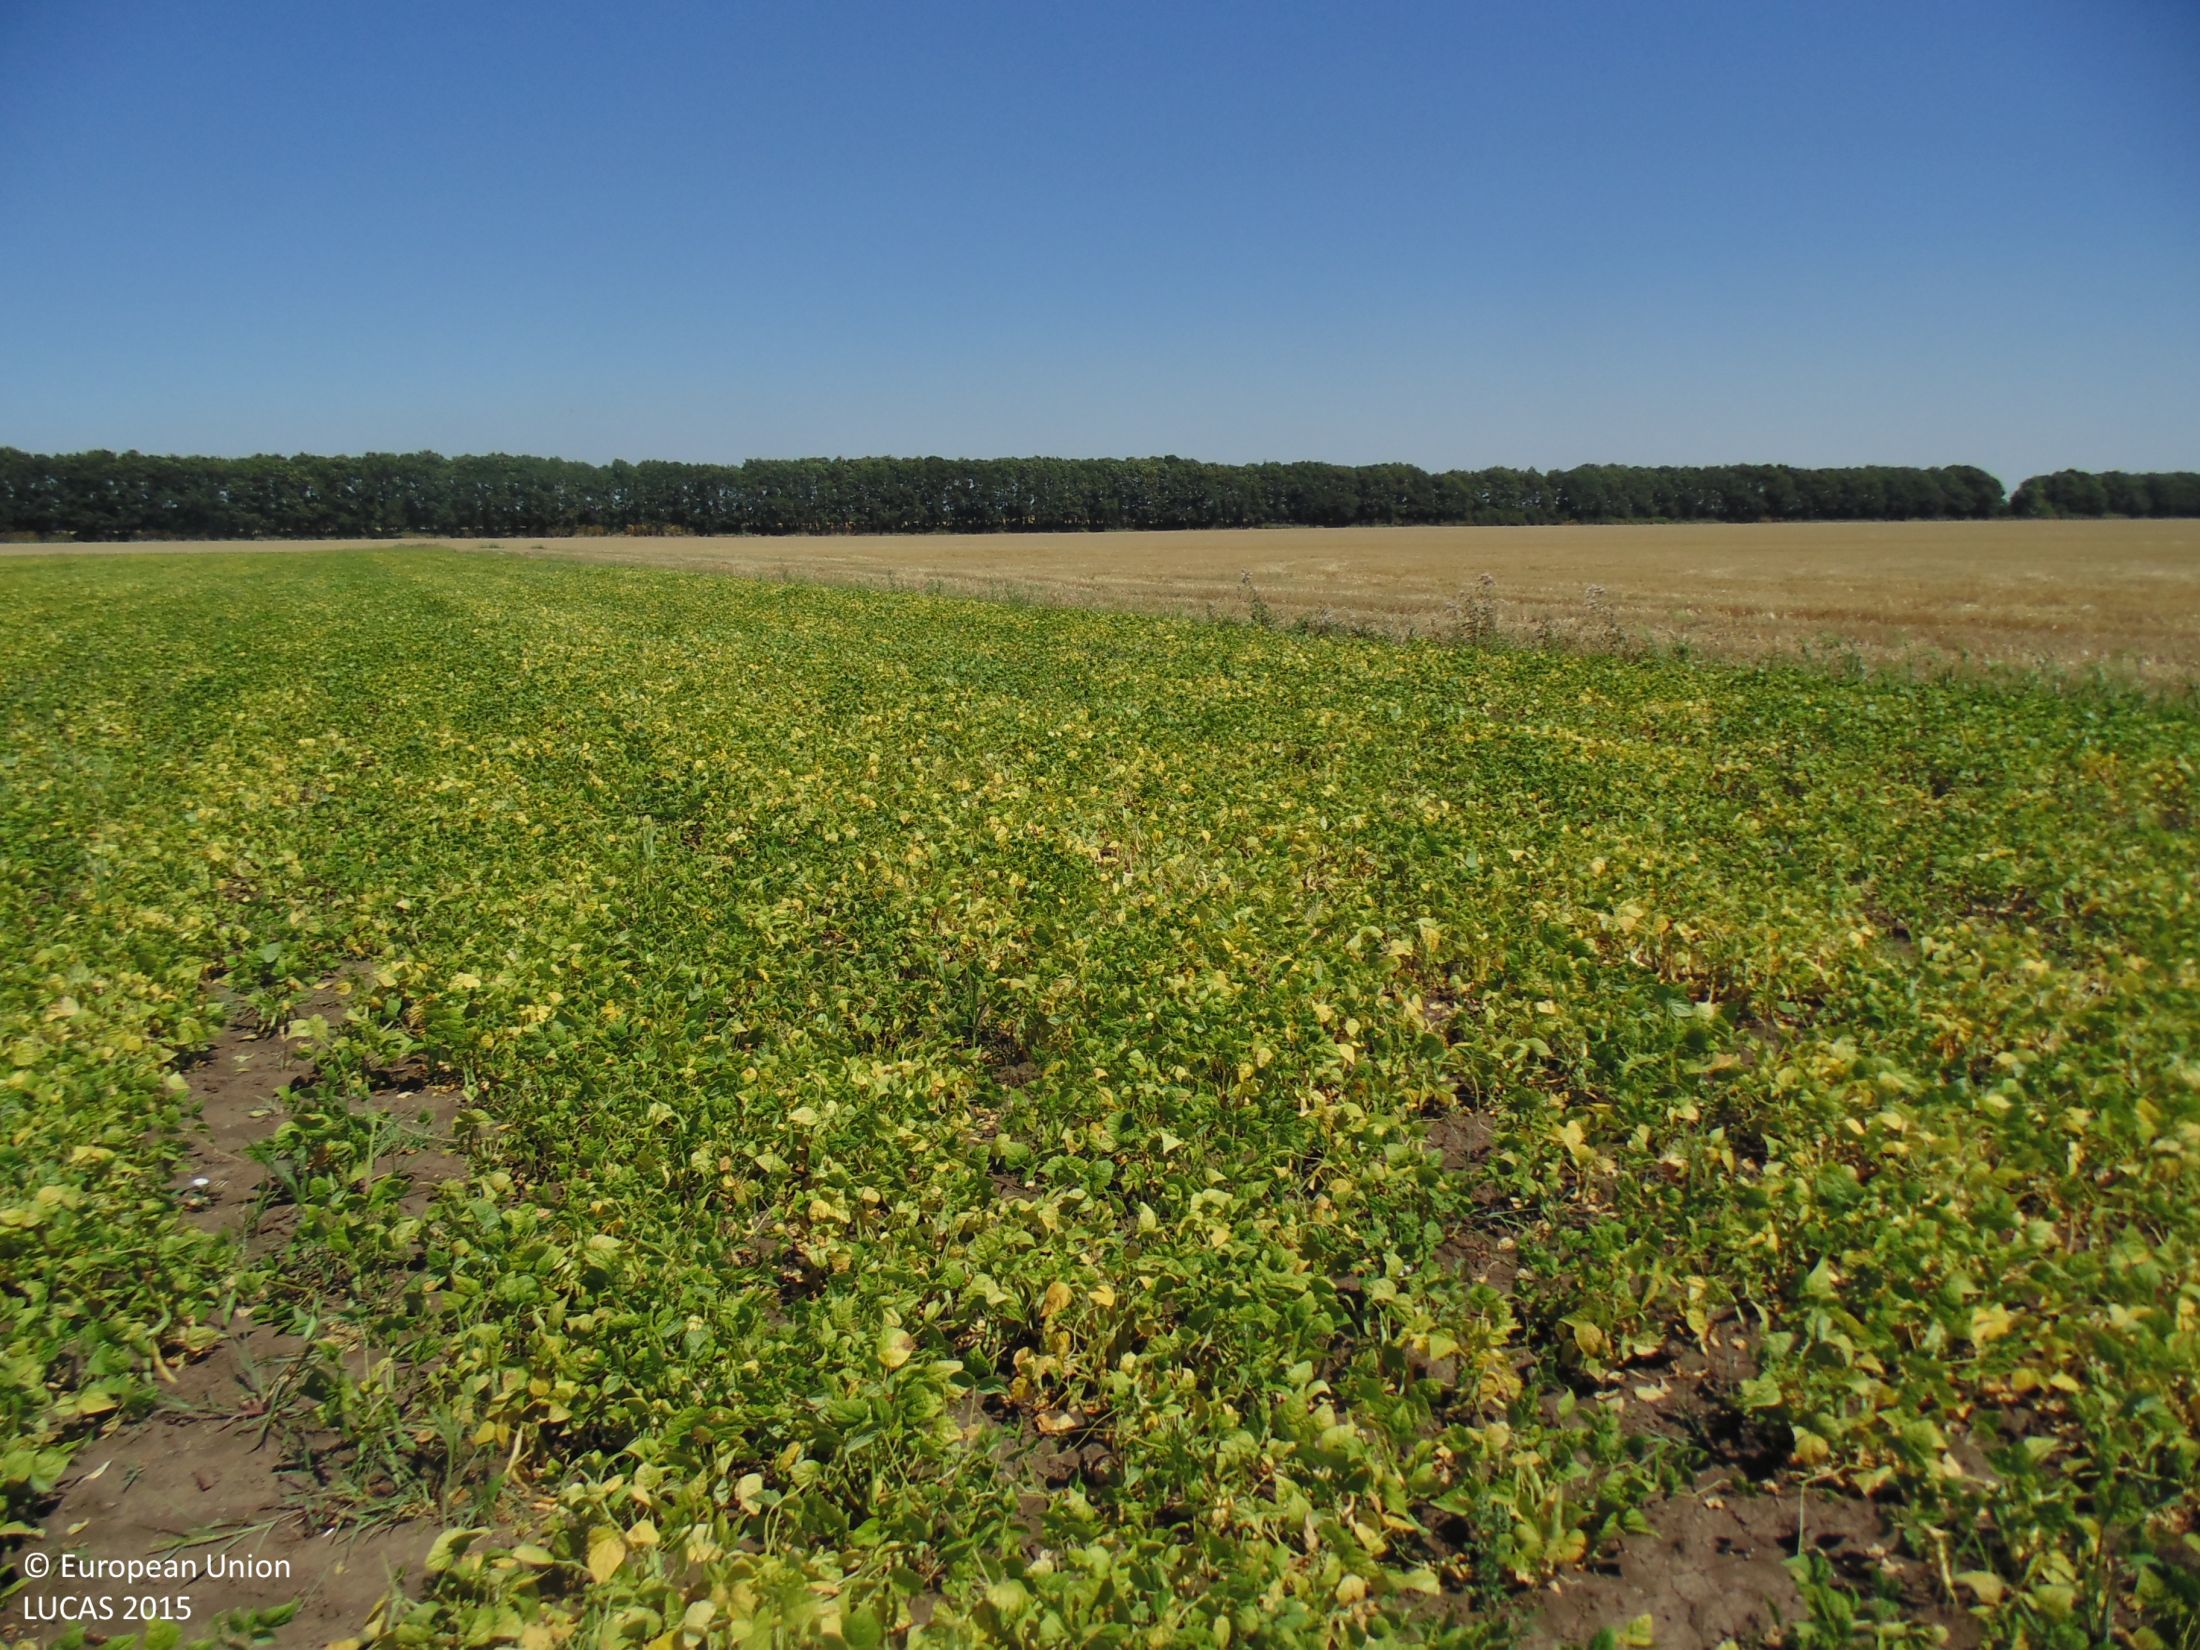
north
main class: Cropland
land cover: Dry pulses
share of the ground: > 75 %
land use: Agriculture (excluding fallow land and kitchen gardens)
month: July
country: BG
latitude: 43.4565
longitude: 28.1307
